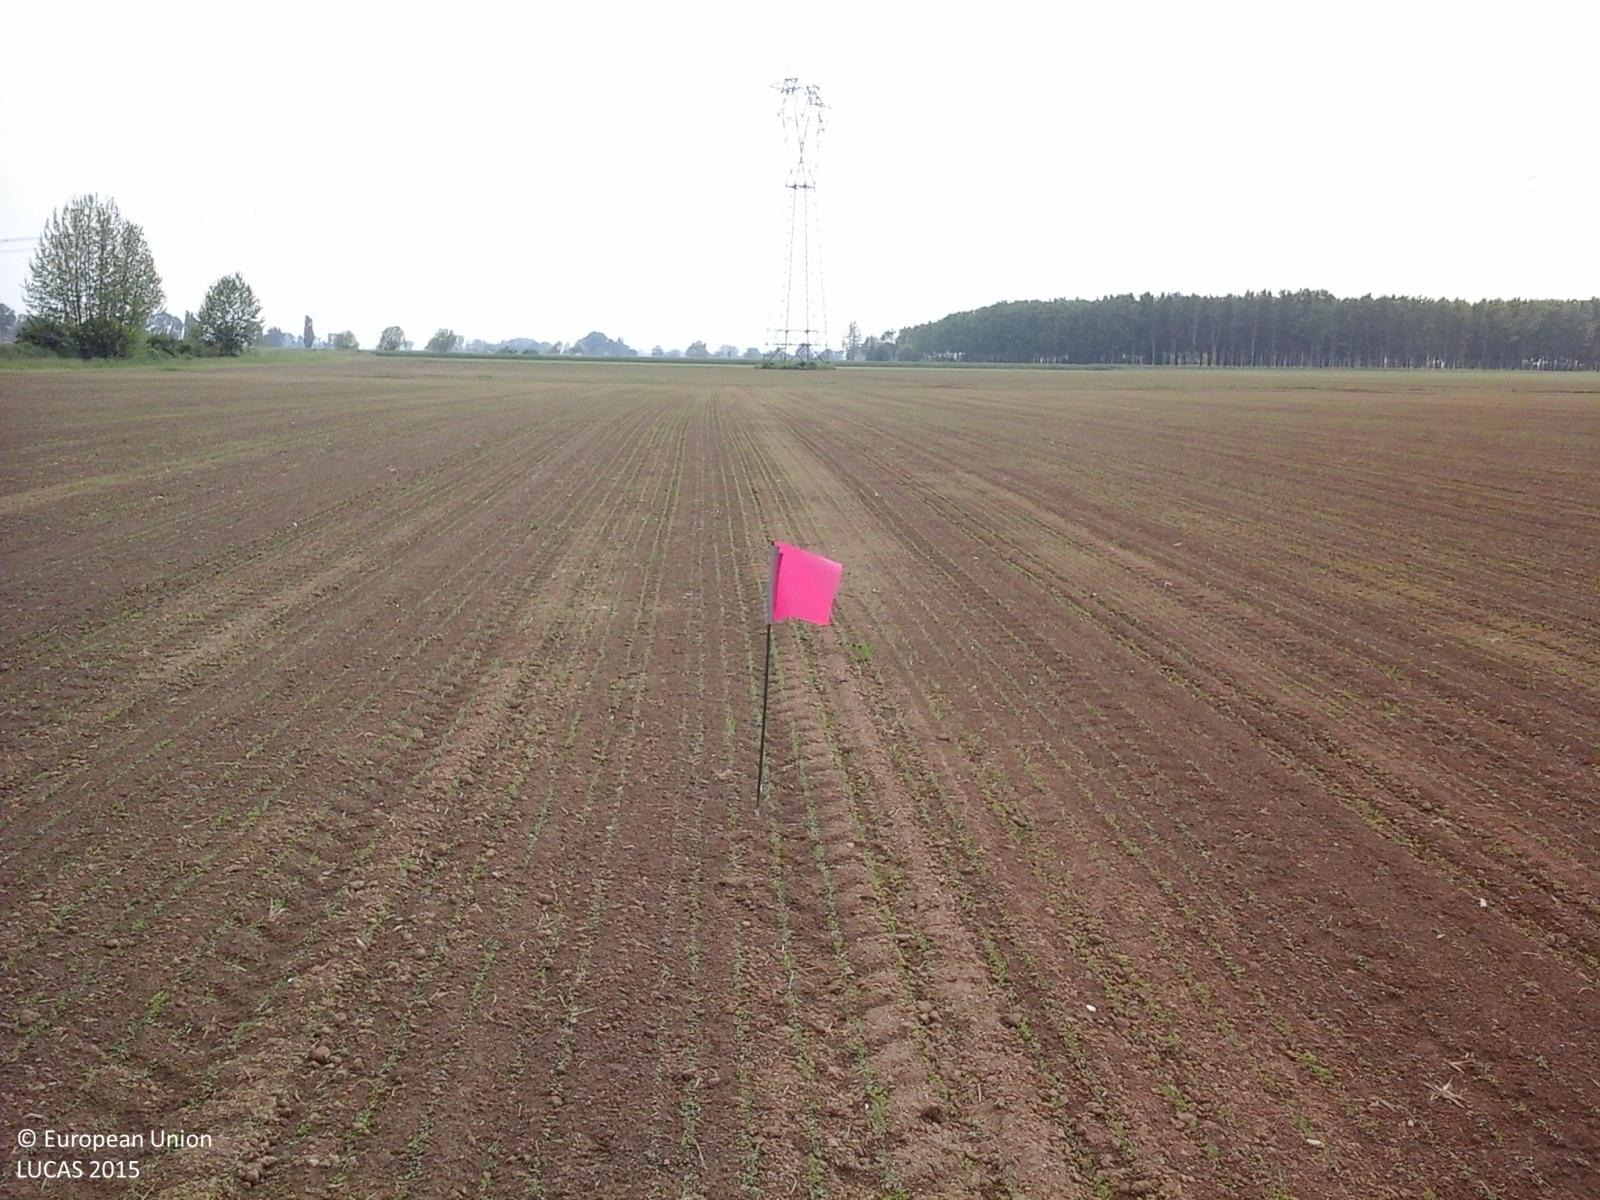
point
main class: Cropland
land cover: Lucerne
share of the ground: < 10 %
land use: Agriculture (excluding fallow land and kitchen gardens)
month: May
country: IT
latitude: 45.0894
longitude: 10.2917
